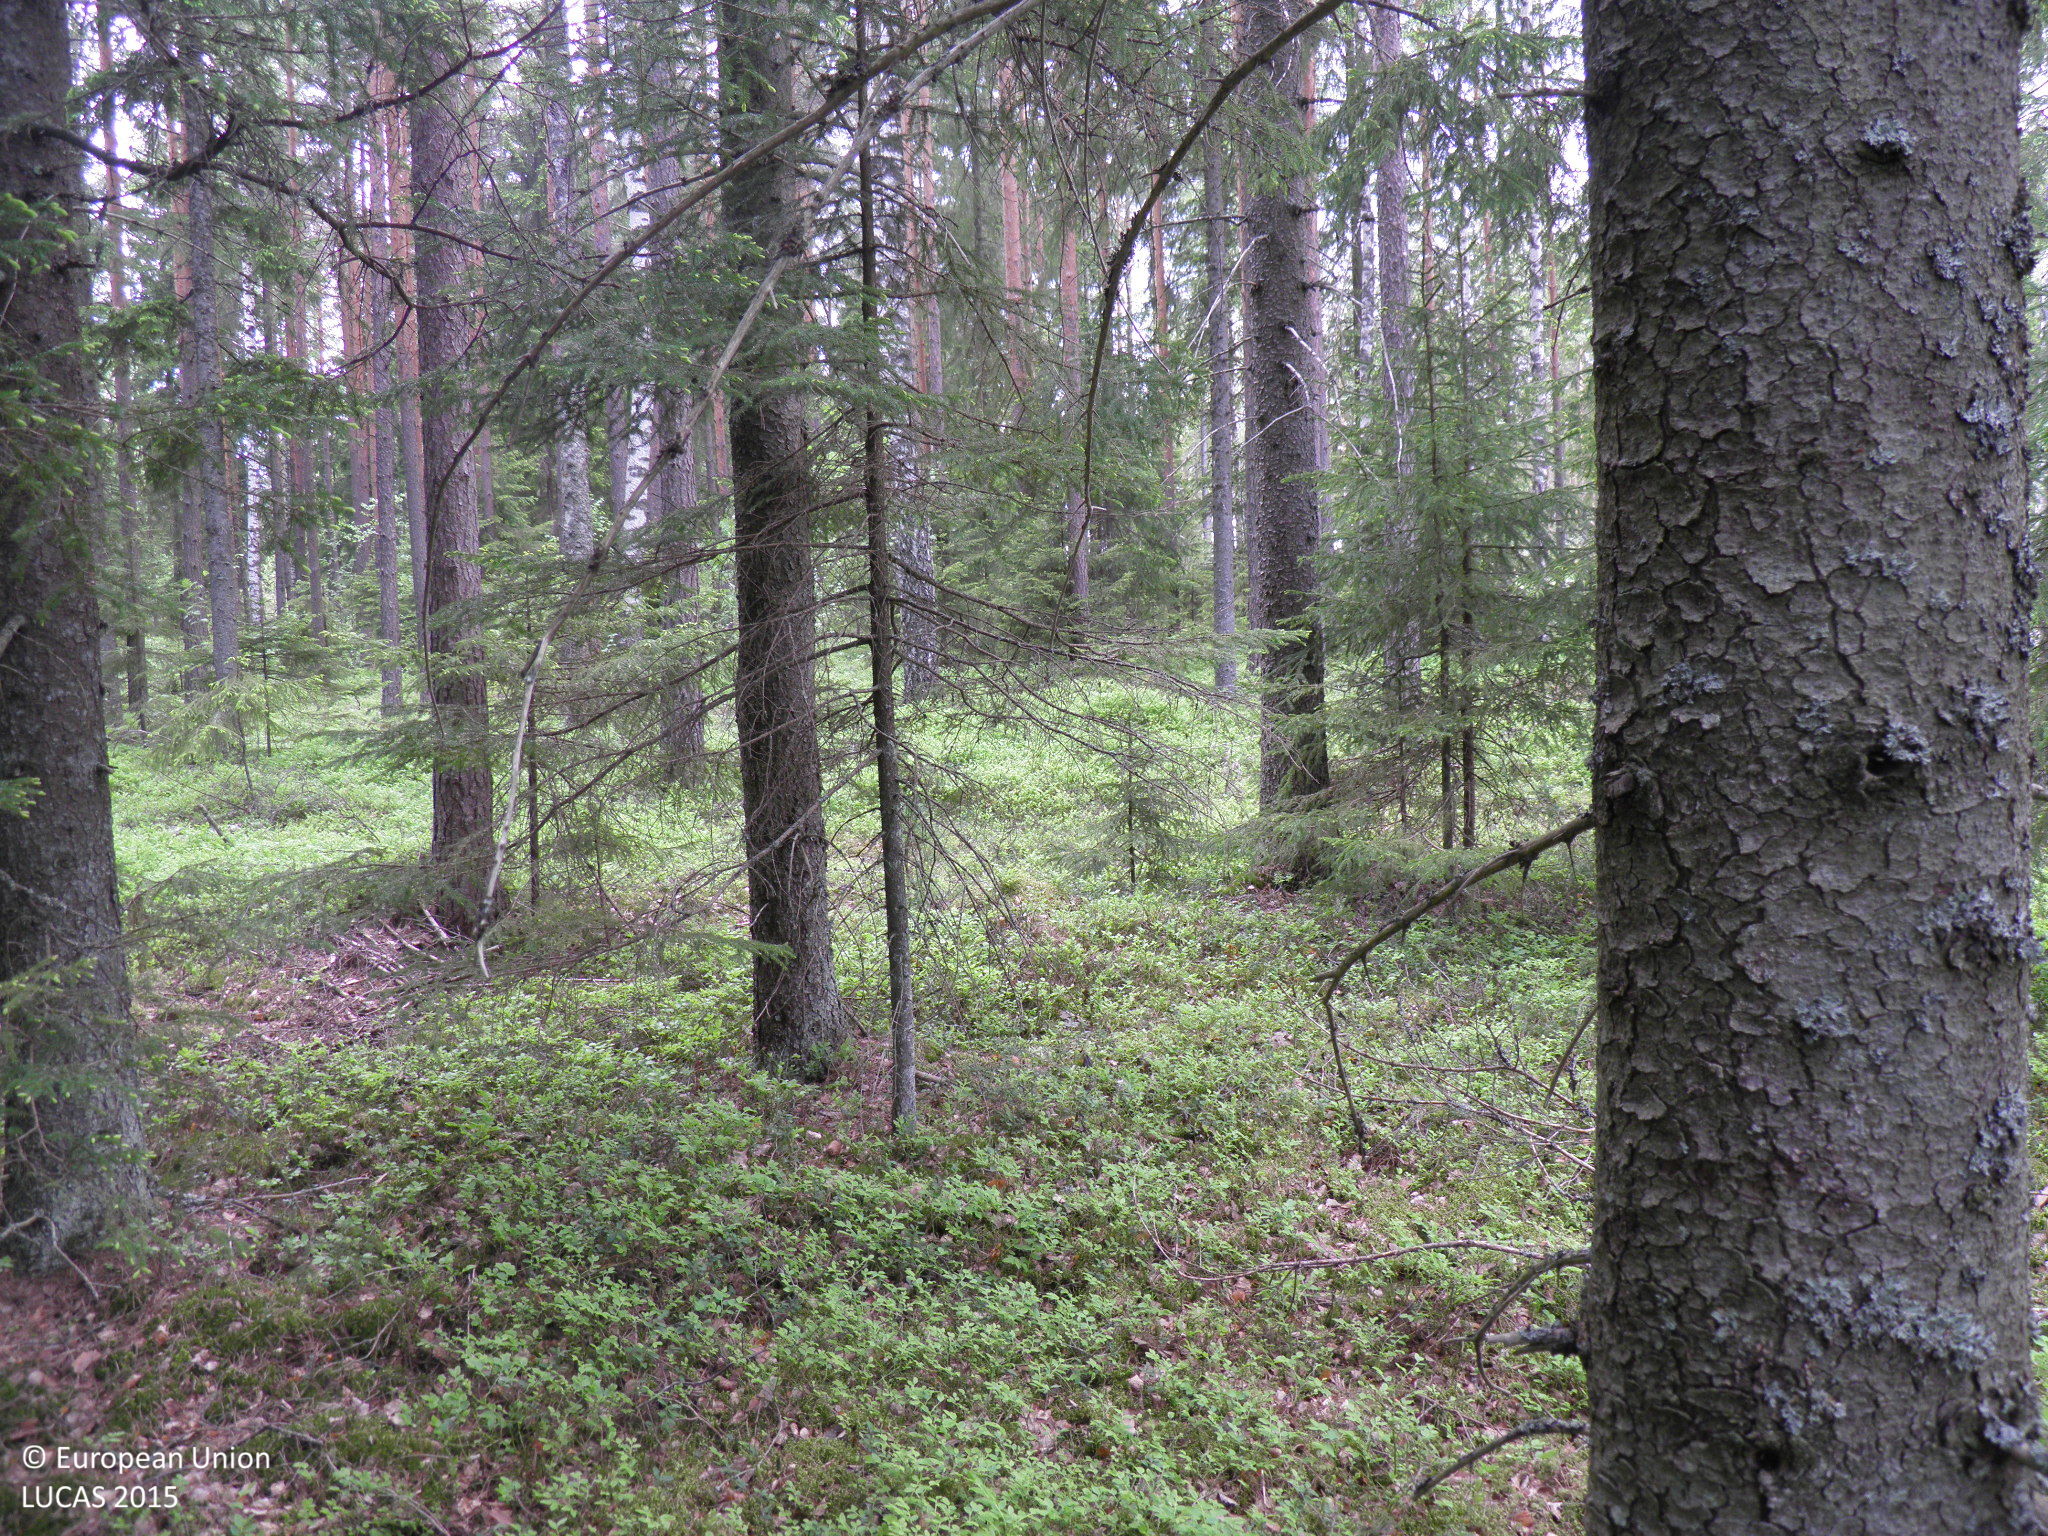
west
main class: Woodland
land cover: Pine dominated coniferous woodland
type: boreal forest
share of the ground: > 75 %
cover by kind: coniferous forest trees 70 %, broadleaved forest trees 20 %, shrubs 5 %, lichens and mosses 5 %
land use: Forestry
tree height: > 5 m
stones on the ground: < 10 %
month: June
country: FI
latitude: 60.5738
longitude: 22.6812
